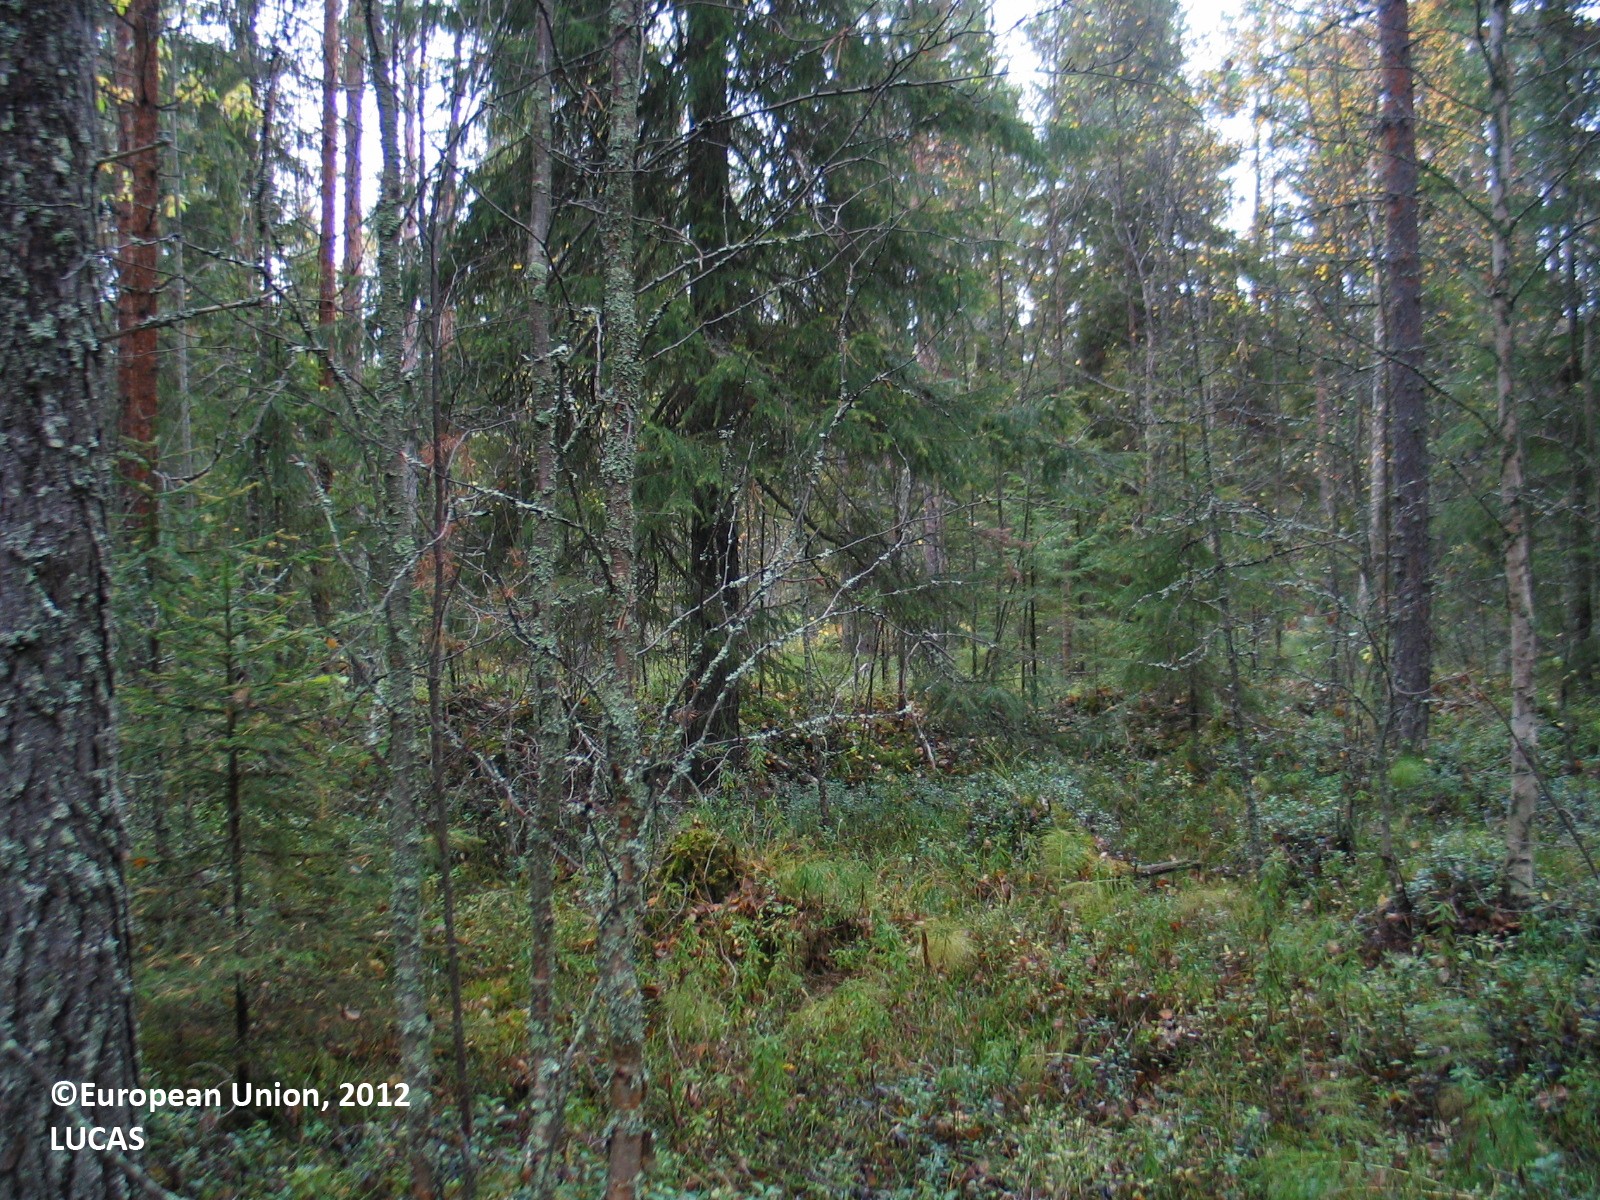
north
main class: Woodland
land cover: Pine dominated coniferous woodland
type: mire and swamp forests
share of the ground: 50 - 75 %
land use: Forestry
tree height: > 5 m
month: September
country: FI
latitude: 65.3824
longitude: 25.5490
